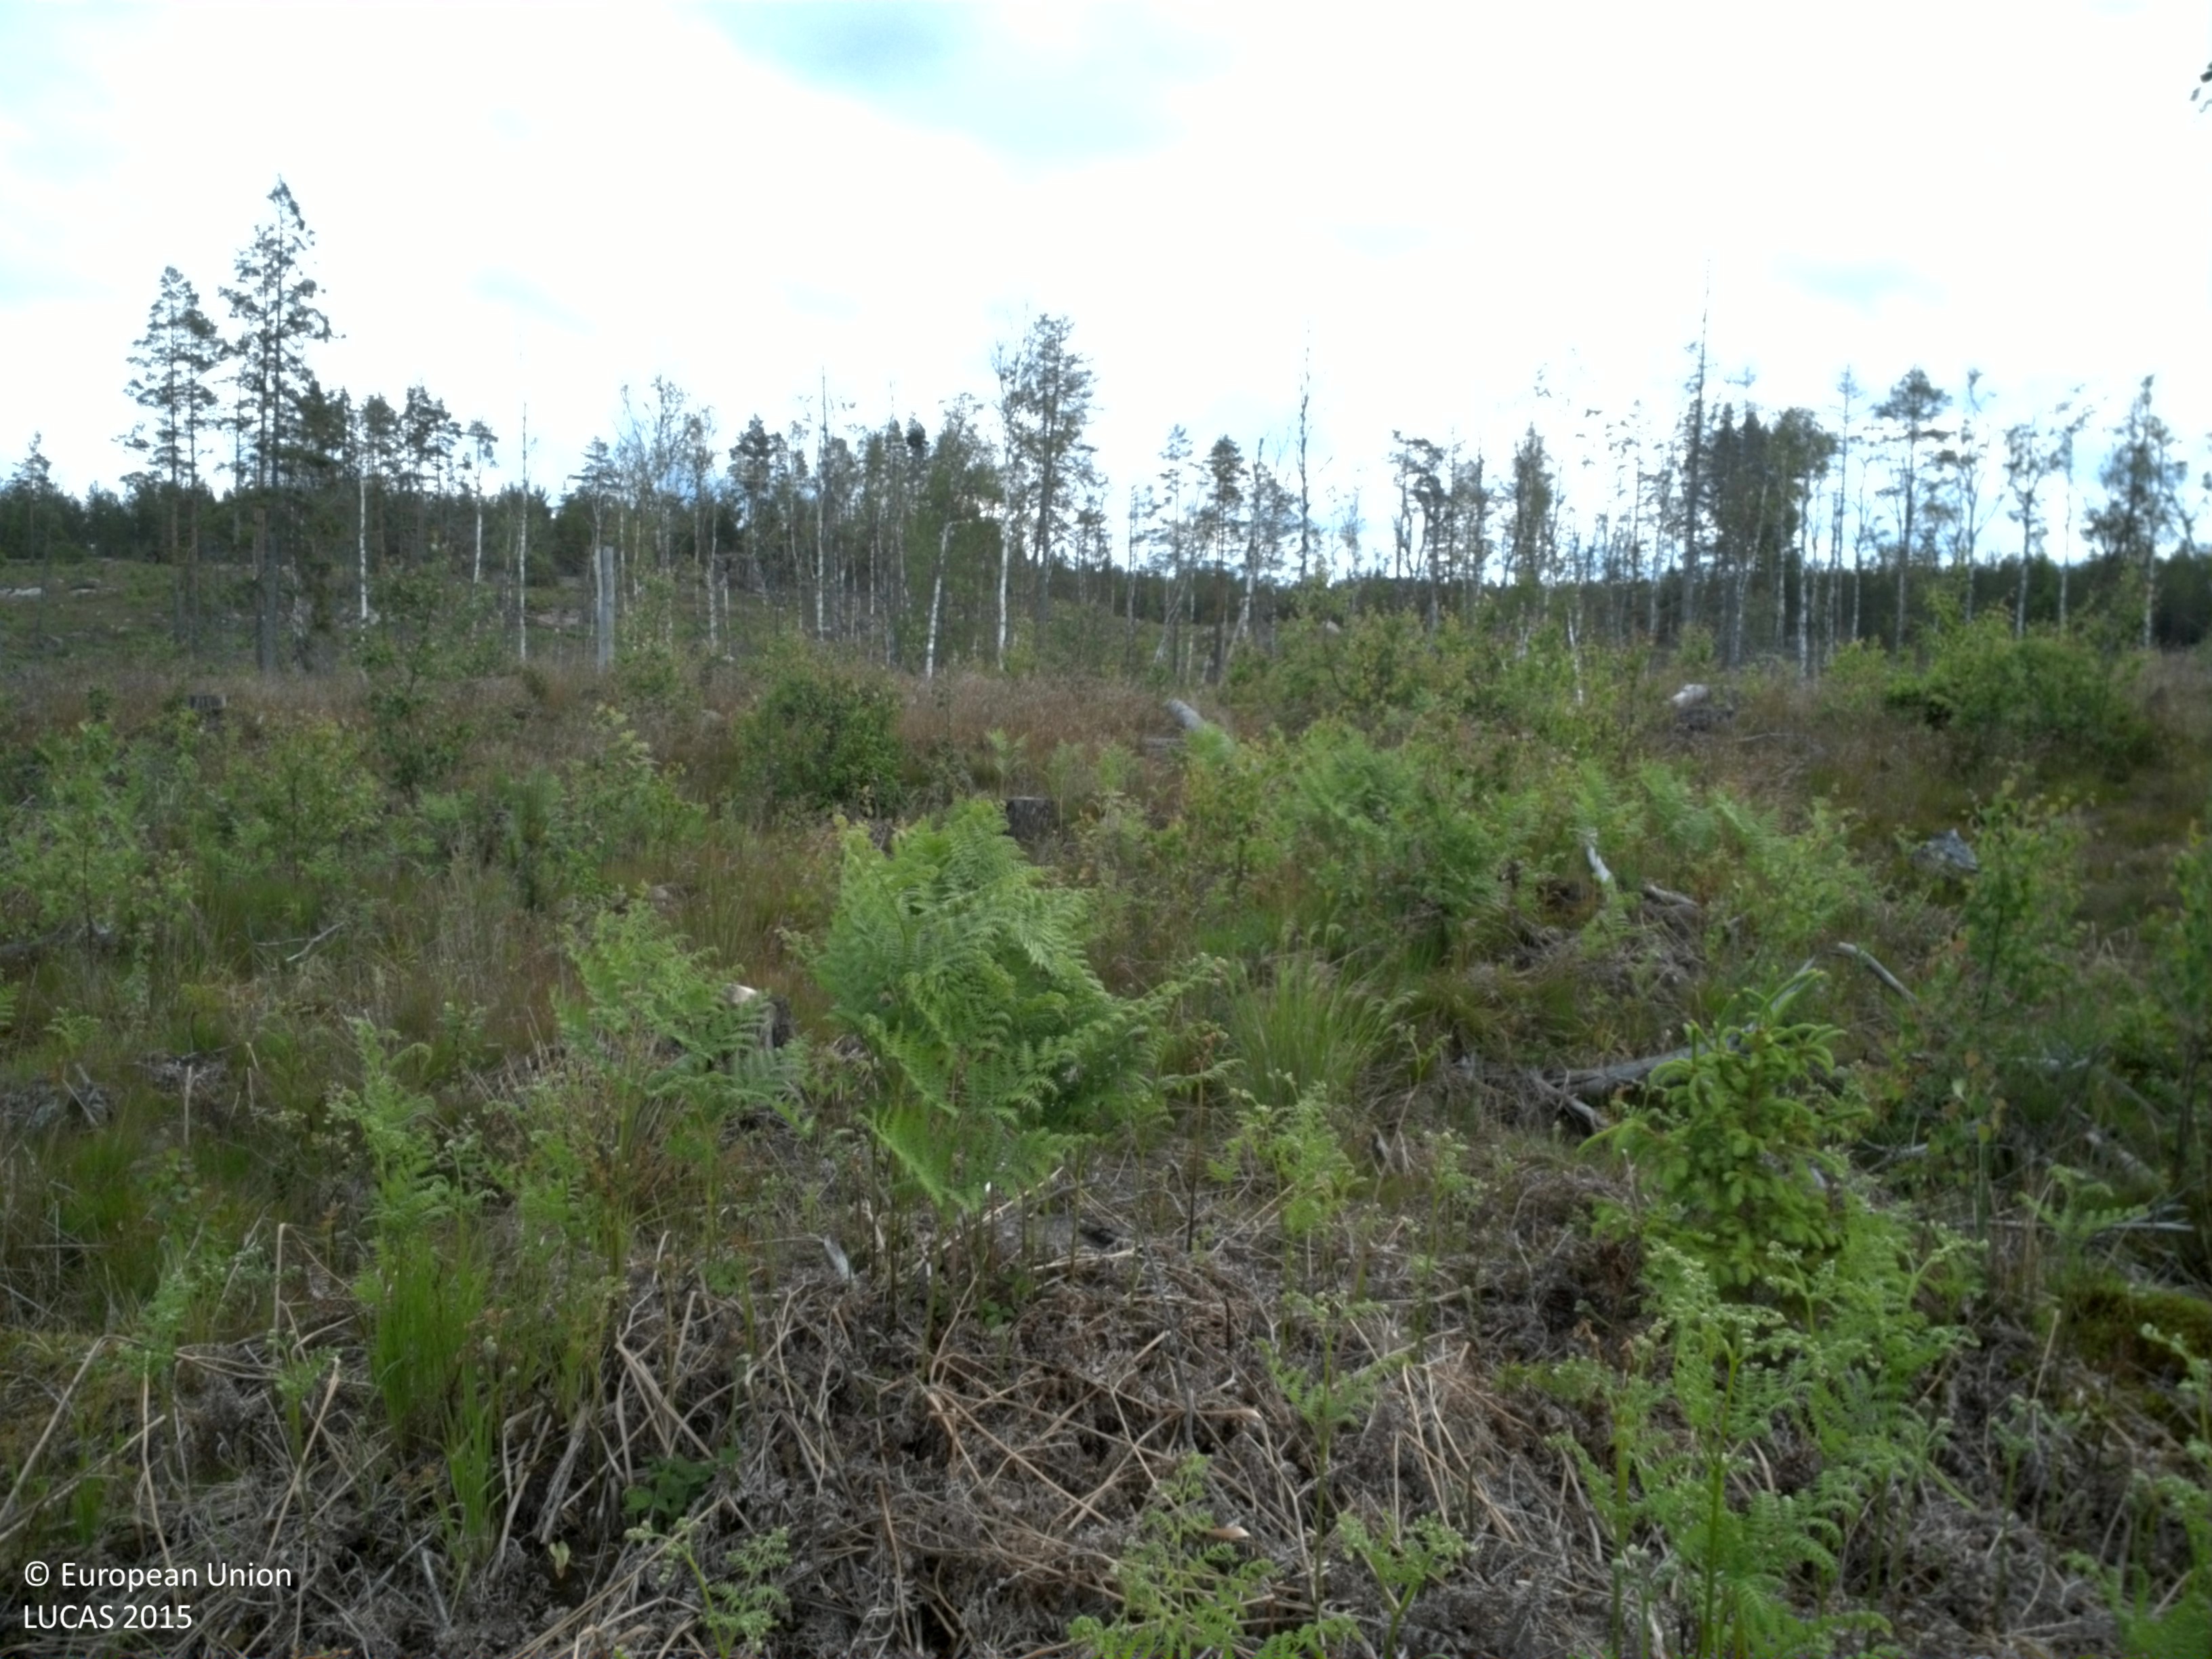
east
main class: Woodland
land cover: Spruce dominated mixed woodland
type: boreal forest
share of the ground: 50 - 75 %
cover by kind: coniferous forest trees 35 %, herbaceous plants 30 %, broadleaved forest trees 25 %, lichens and mosses 10 %
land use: Forestry
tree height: < 5 m
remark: Clear cut
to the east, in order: Spruce dominated mixed woodland; Inland marshes; Broadleaved woodland; Spruce dominated mixed woodland
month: June
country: SE
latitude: 58.6484
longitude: 15.4907
